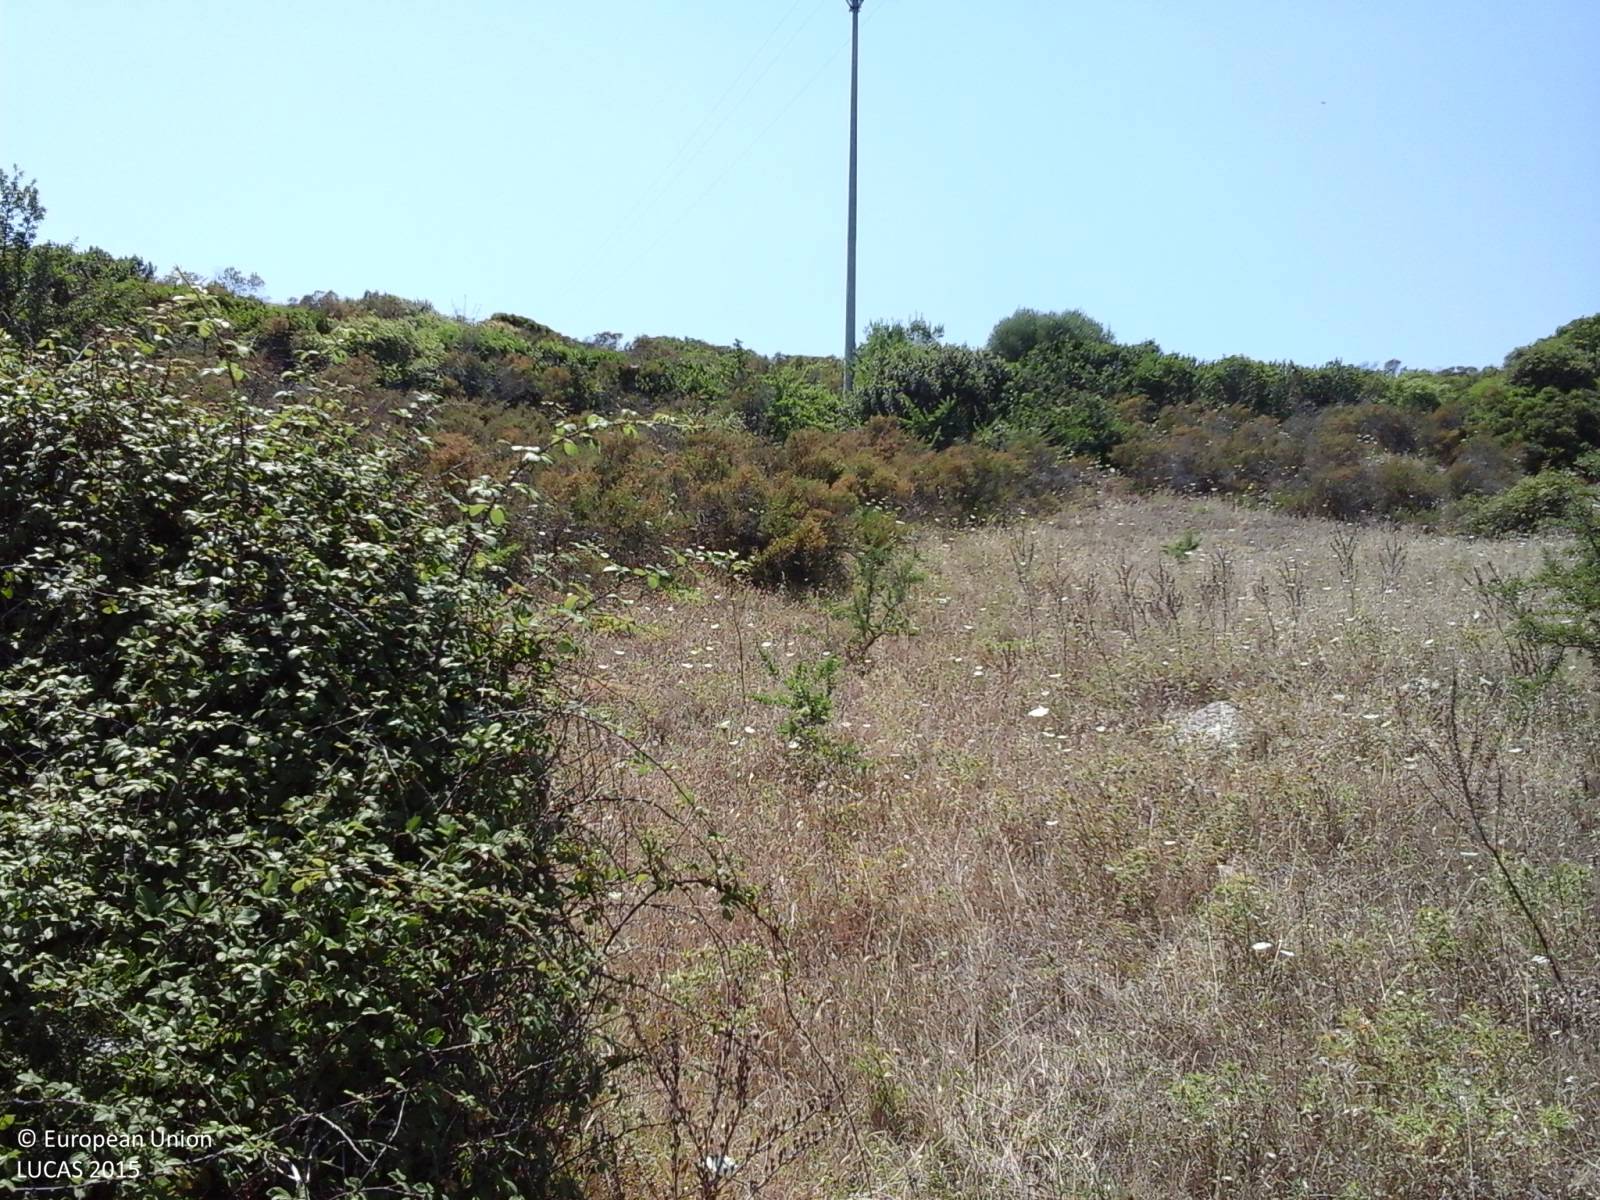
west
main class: Grassland
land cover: Grassland with sparse tree/shrub cover
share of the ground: > 75 %
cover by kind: herbaceous plants 90 %, broadleaved forest trees 5 %, shrubs 5 %
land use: Agriculture (excluding fallow land and kitchen gardens)
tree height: < 5 m
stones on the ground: > 50 %
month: June
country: IT
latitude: 39.8803
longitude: 8.8488
